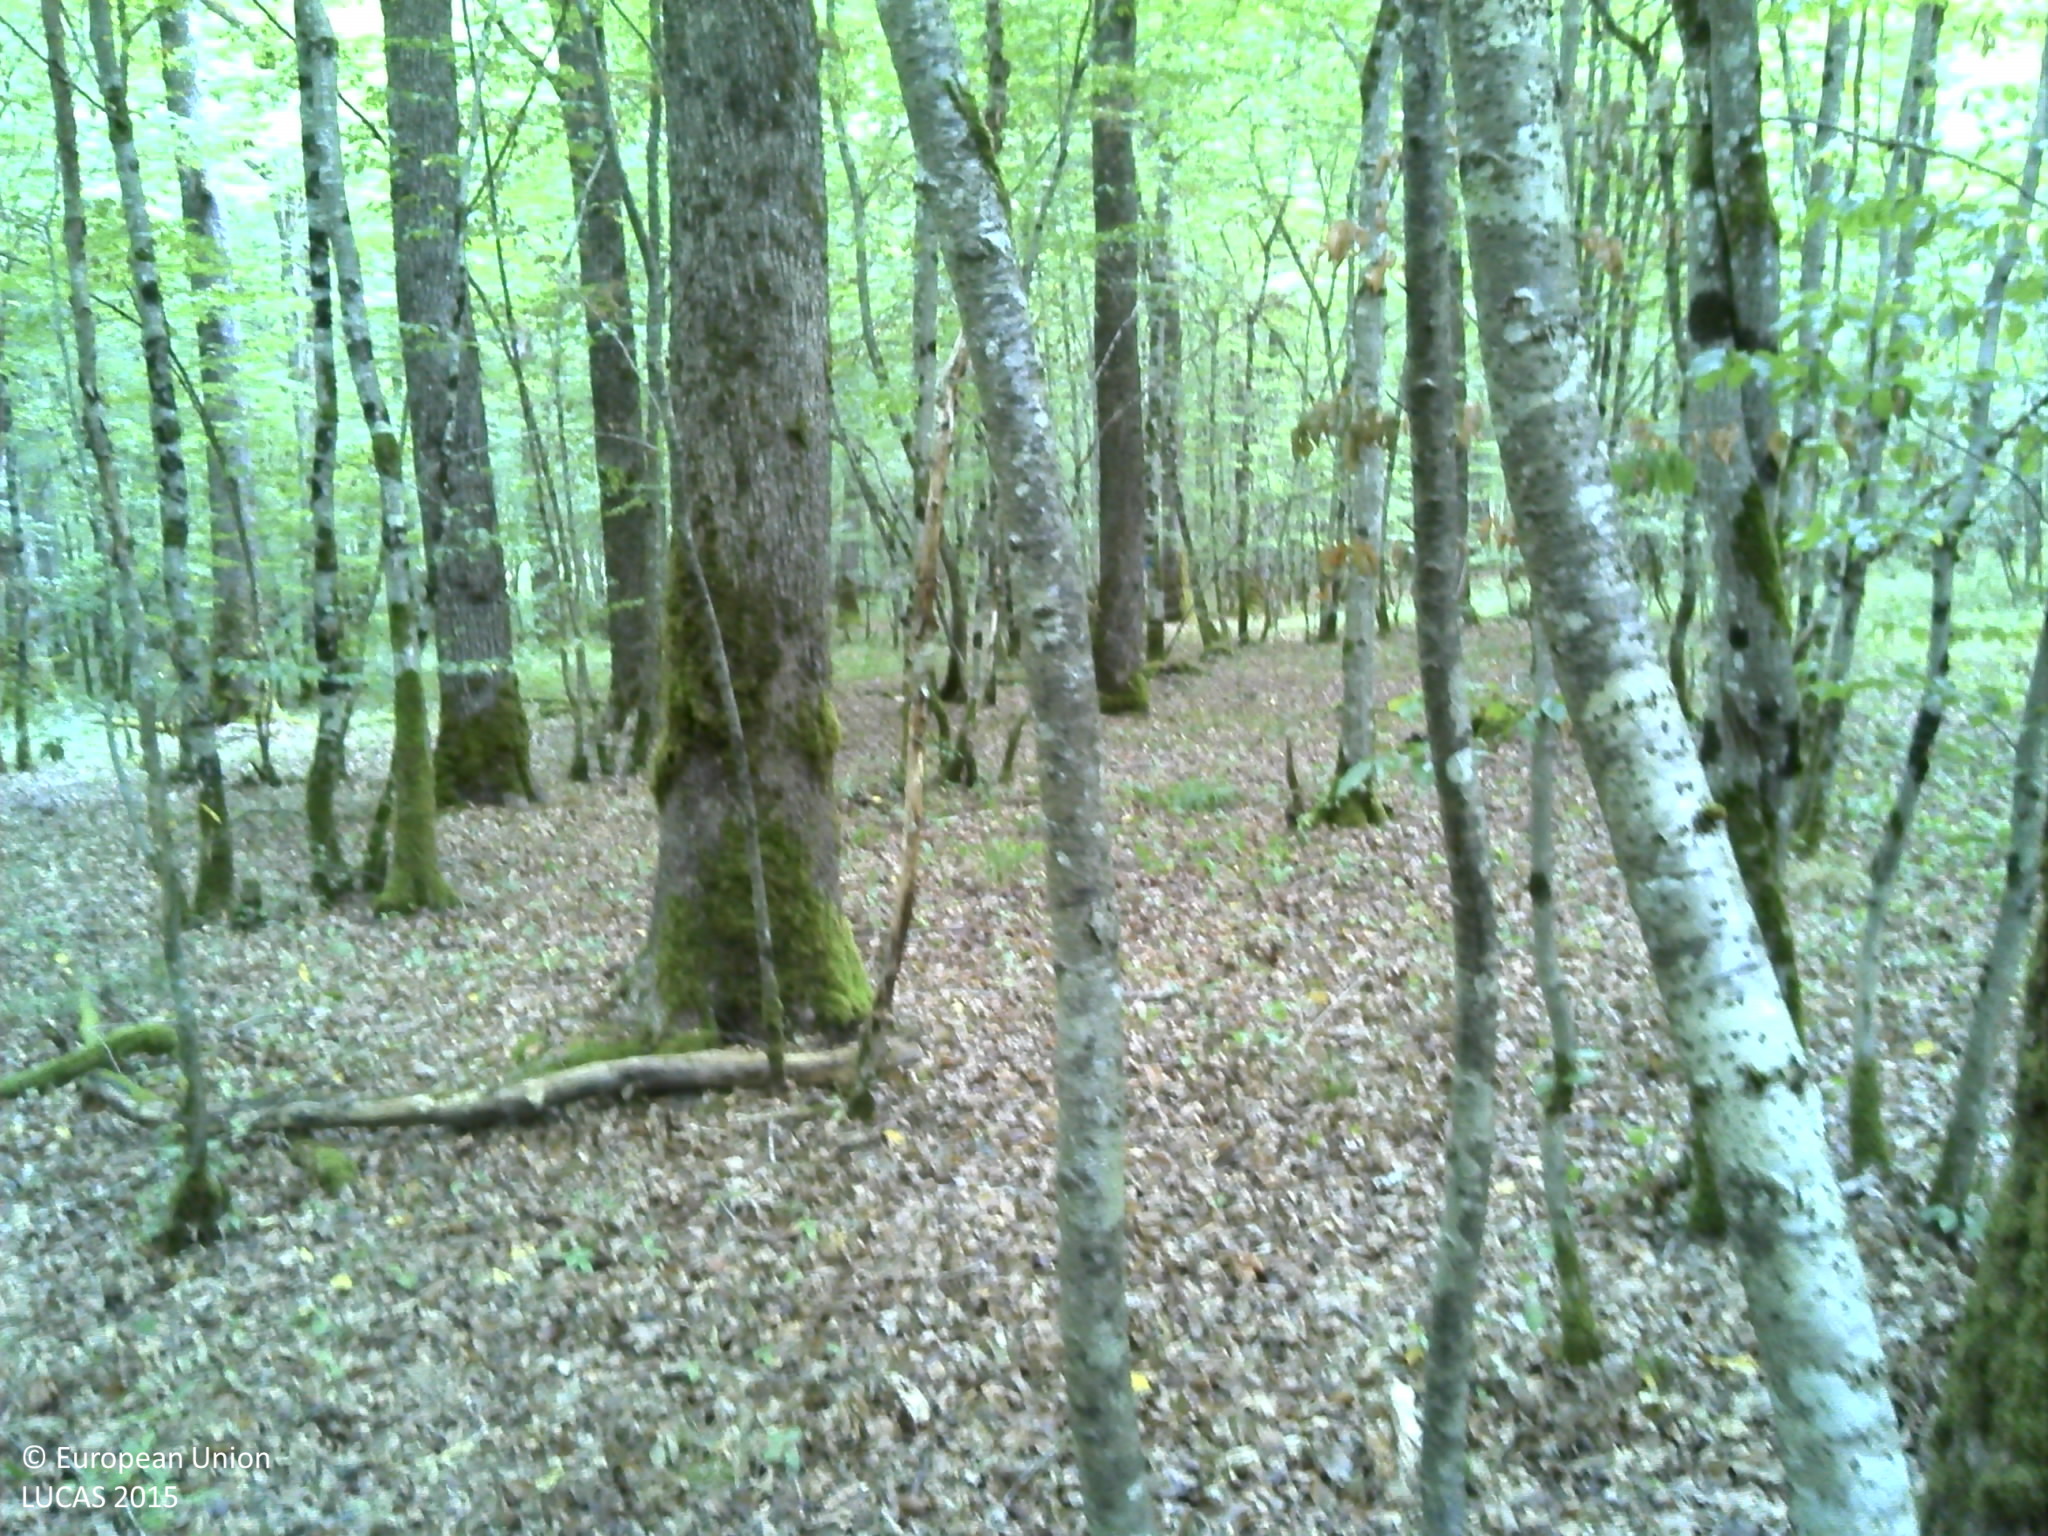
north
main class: Woodland
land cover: Broadleaved woodland
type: beech forest
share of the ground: > 75 %
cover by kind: broadleaved forest trees 95 %, unconsolidated bare surface 5 %
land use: Forestry
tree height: > 5 m
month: August
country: FR
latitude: 48.2298
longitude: 6.1906
